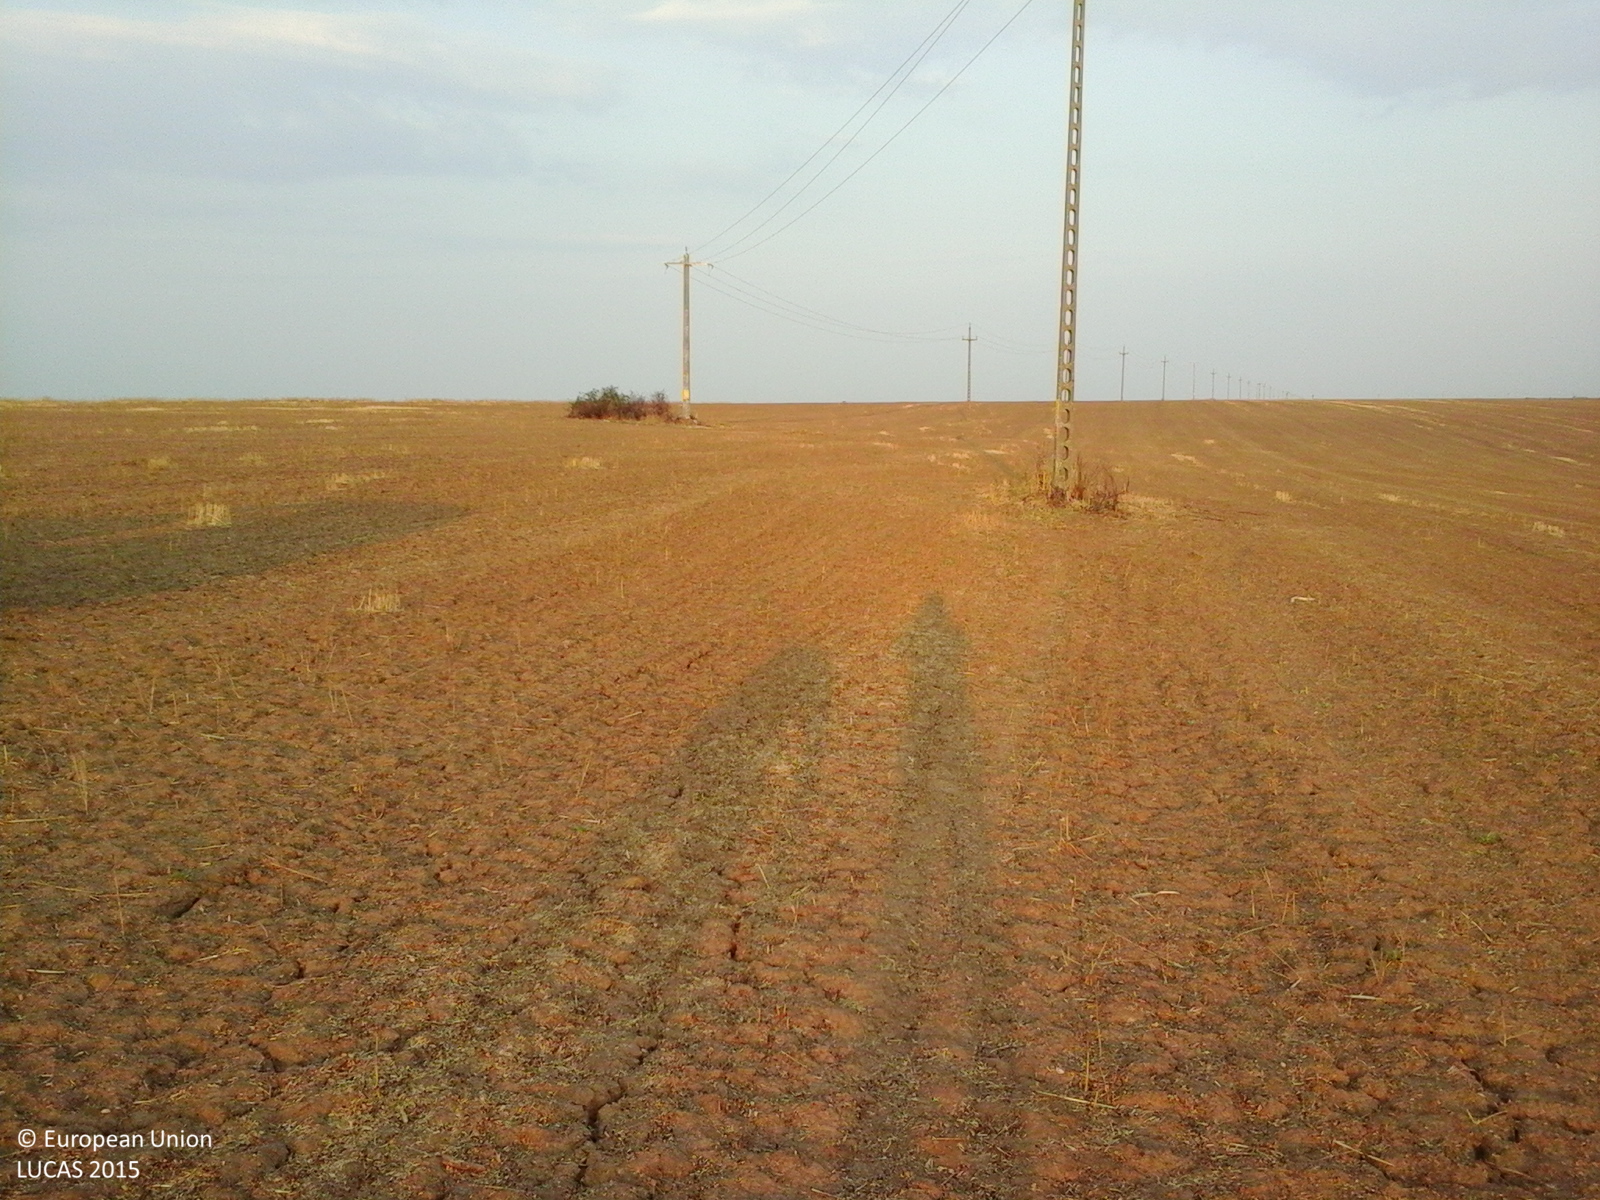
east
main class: Cropland
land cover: Common wheat
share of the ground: < 10 %
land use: Agriculture (excluding fallow land and kitchen gardens)
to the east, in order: Common wheat; Electric lines; Common wheat; Electric lines; Common wheat
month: August
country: RO
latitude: 44.4143
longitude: 23.0691
